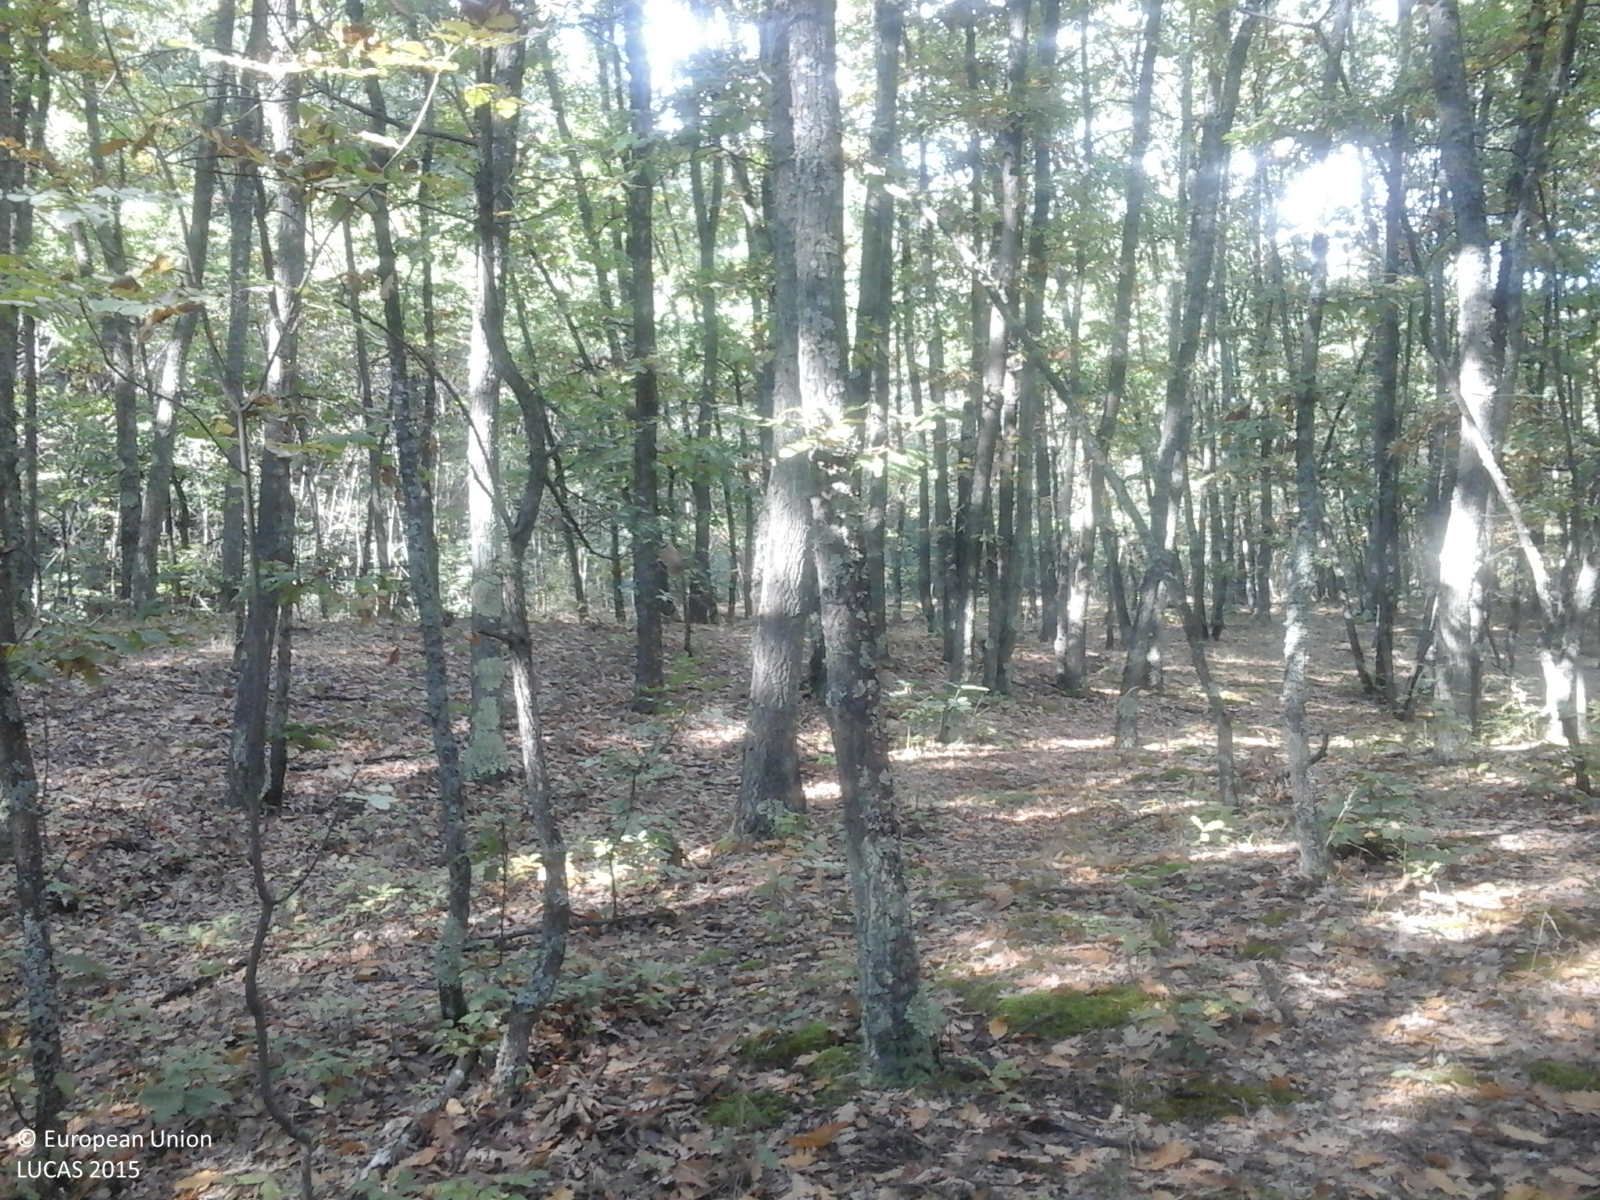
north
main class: Woodland
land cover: Broadleaved woodland
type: acidophilous oak and oak-birch forest
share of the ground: > 75 %
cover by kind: broadleaved forest trees 100 %
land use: Forestry
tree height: > 5 m
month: September
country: RO
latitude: 44.9859
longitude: 23.5912
